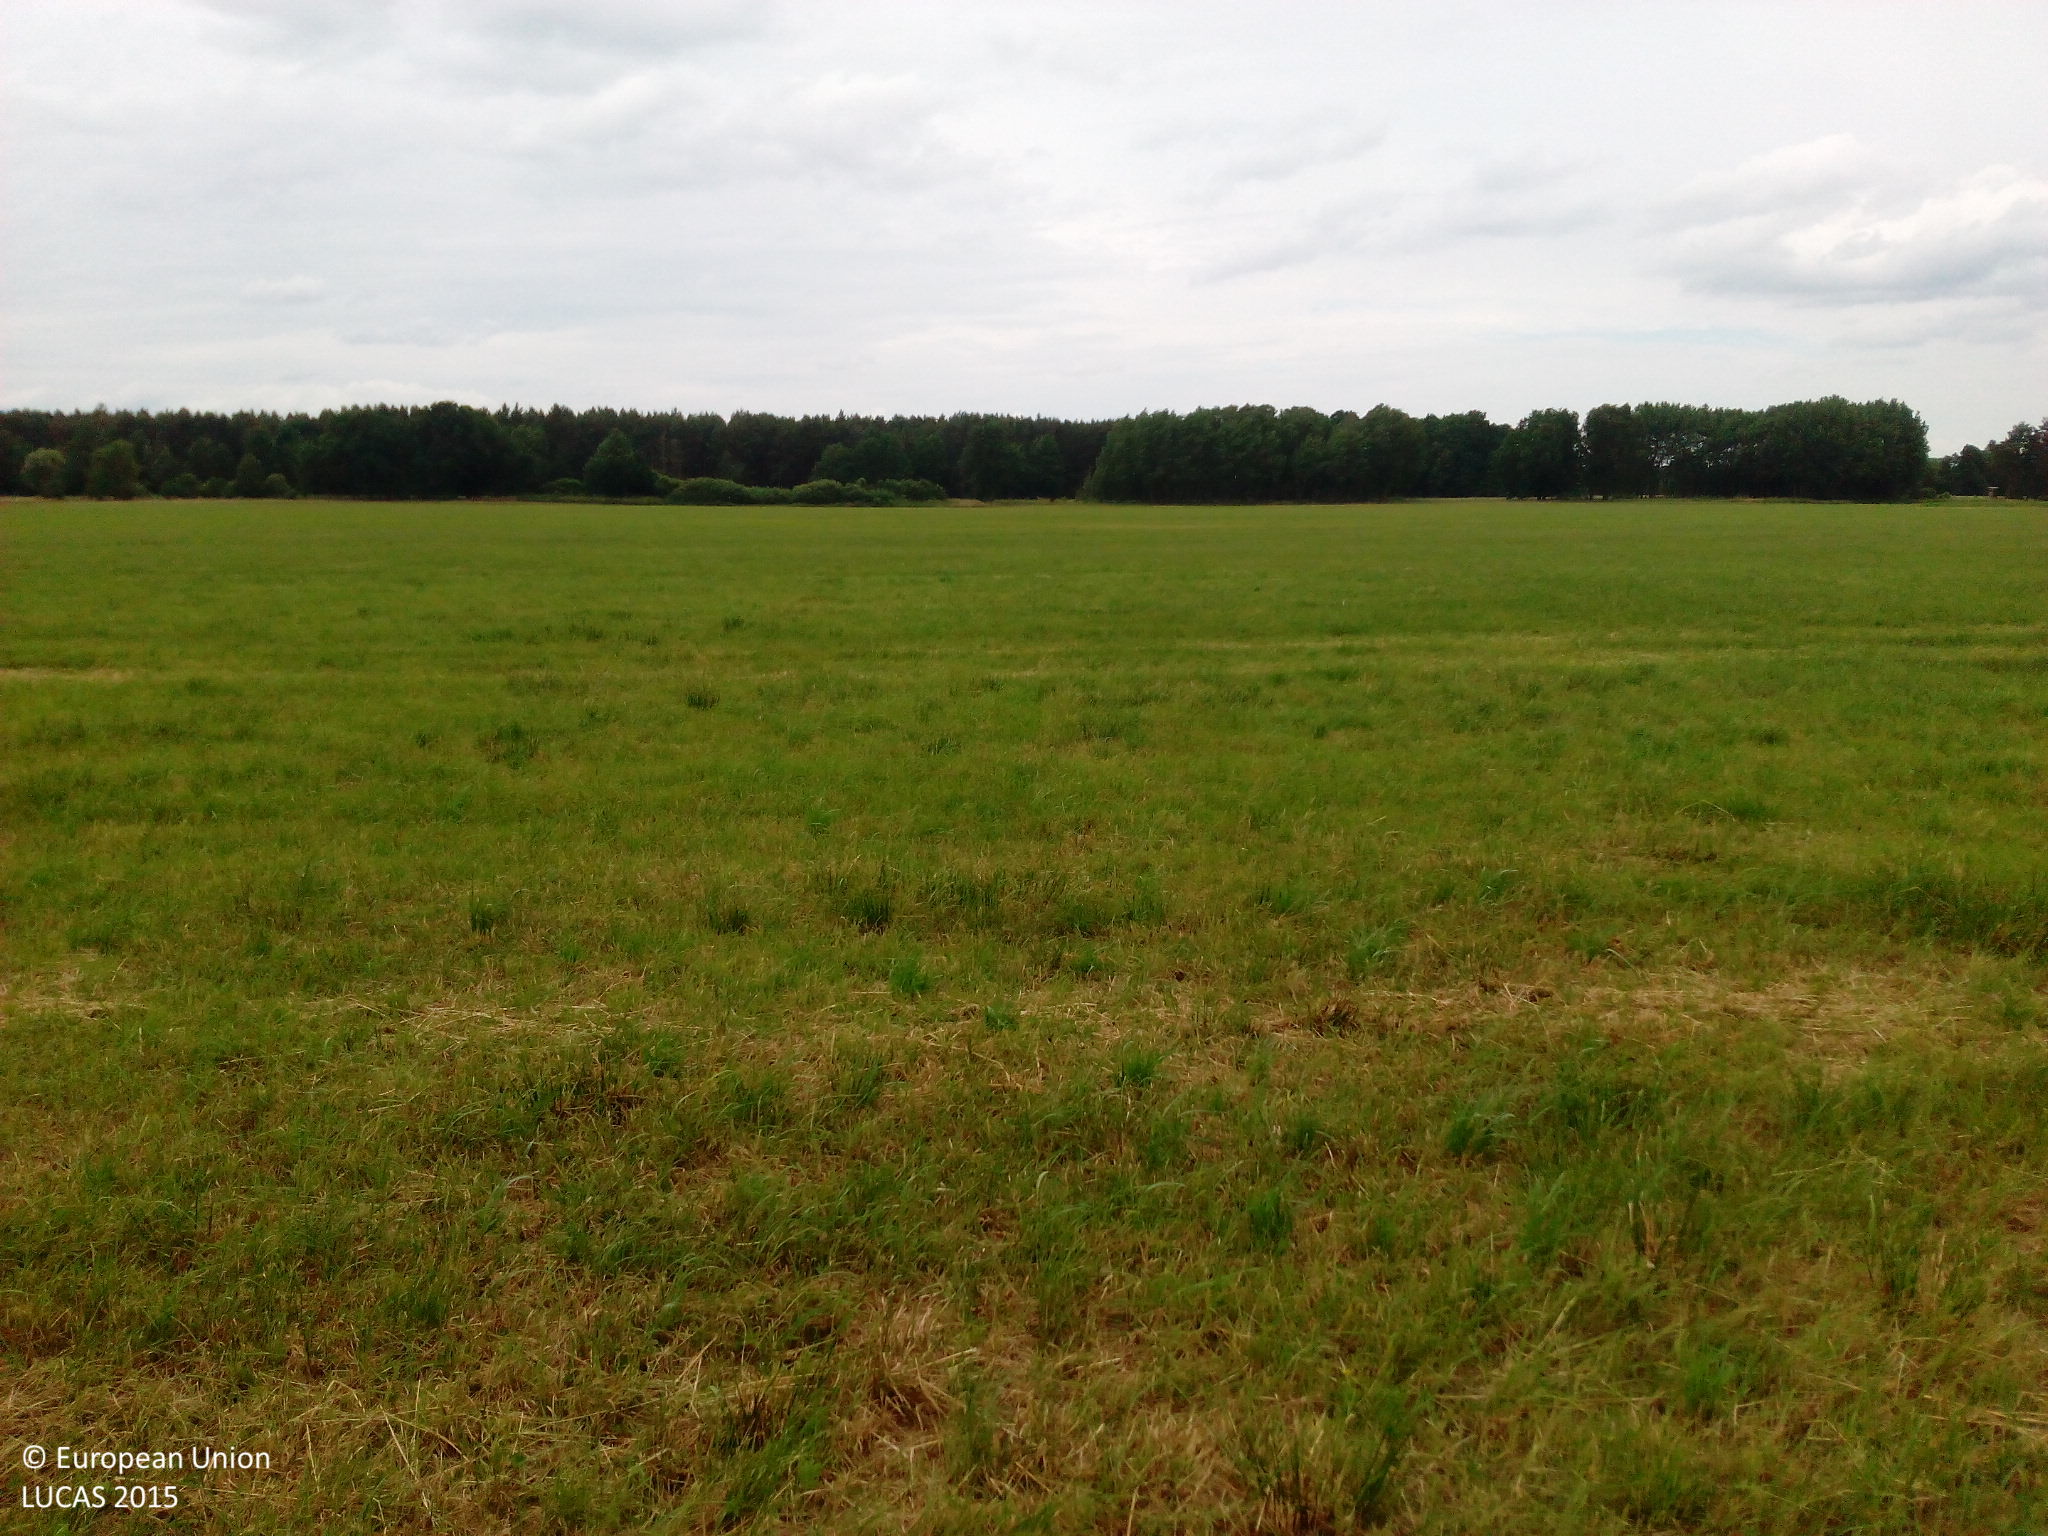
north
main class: Grassland
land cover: Grassland without tree/shrub cover
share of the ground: > 75 %
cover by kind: herbaceous plants 100 %
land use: Agriculture (excluding fallow land and kitchen gardens)
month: June
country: DE
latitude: 52.3163
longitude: 12.4494
